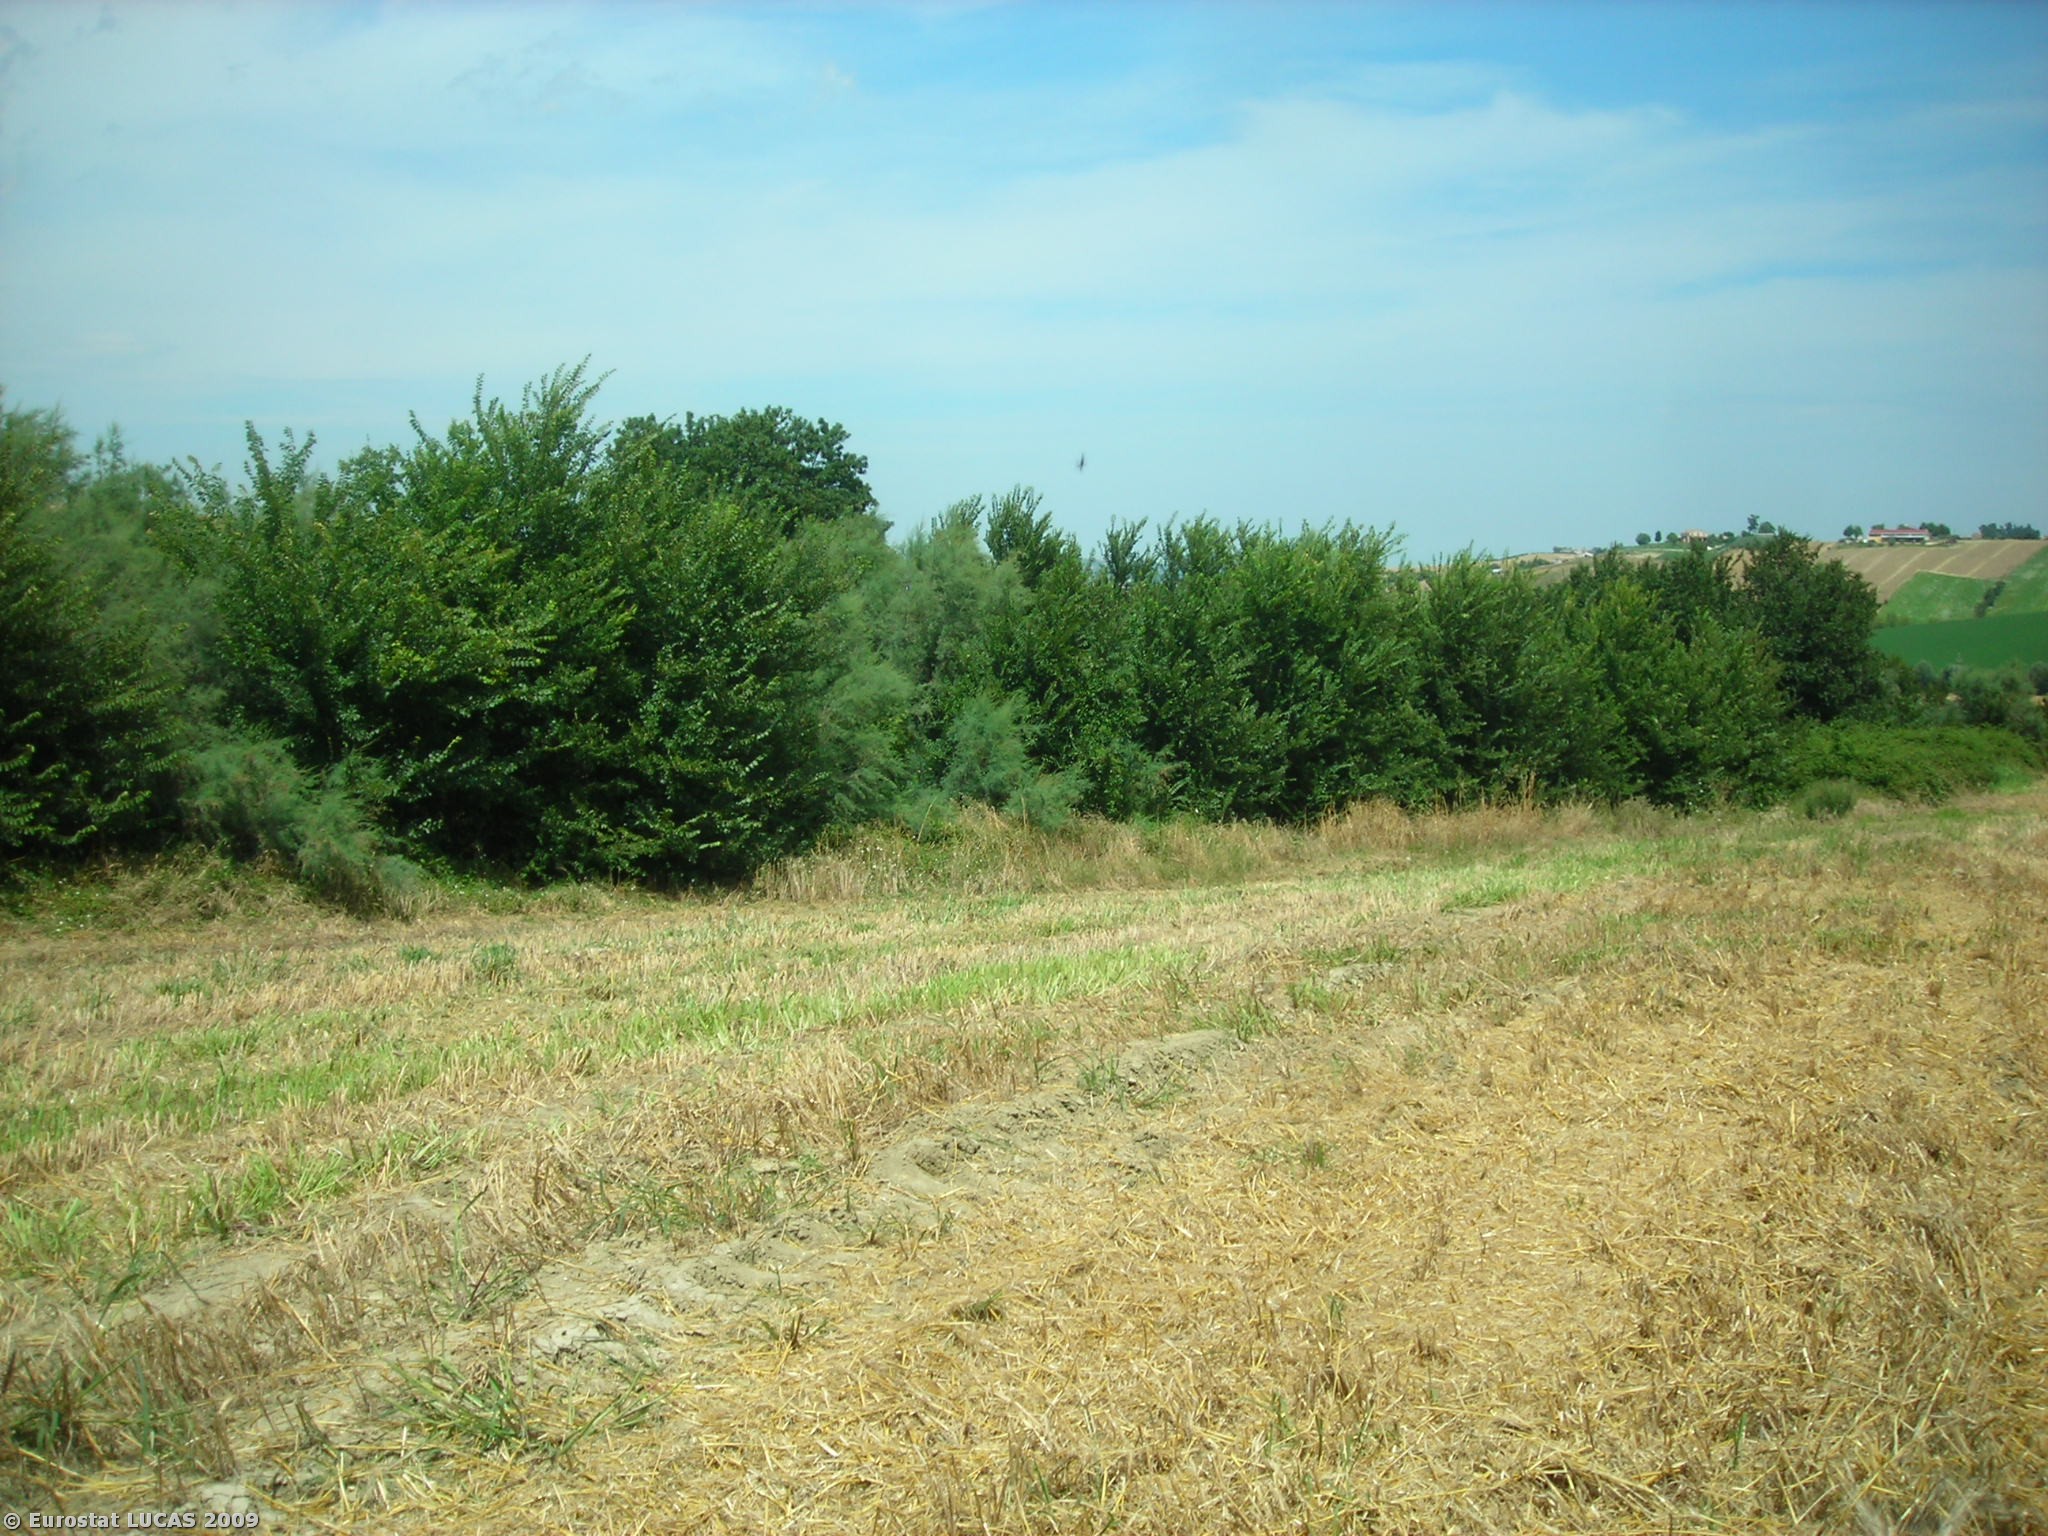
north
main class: Cropland
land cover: Durum wheat
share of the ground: < 10 %
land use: Agriculture (excluding fallow land and kitchen gardens)
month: July
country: IT
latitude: 43.4694
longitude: 13.2429
